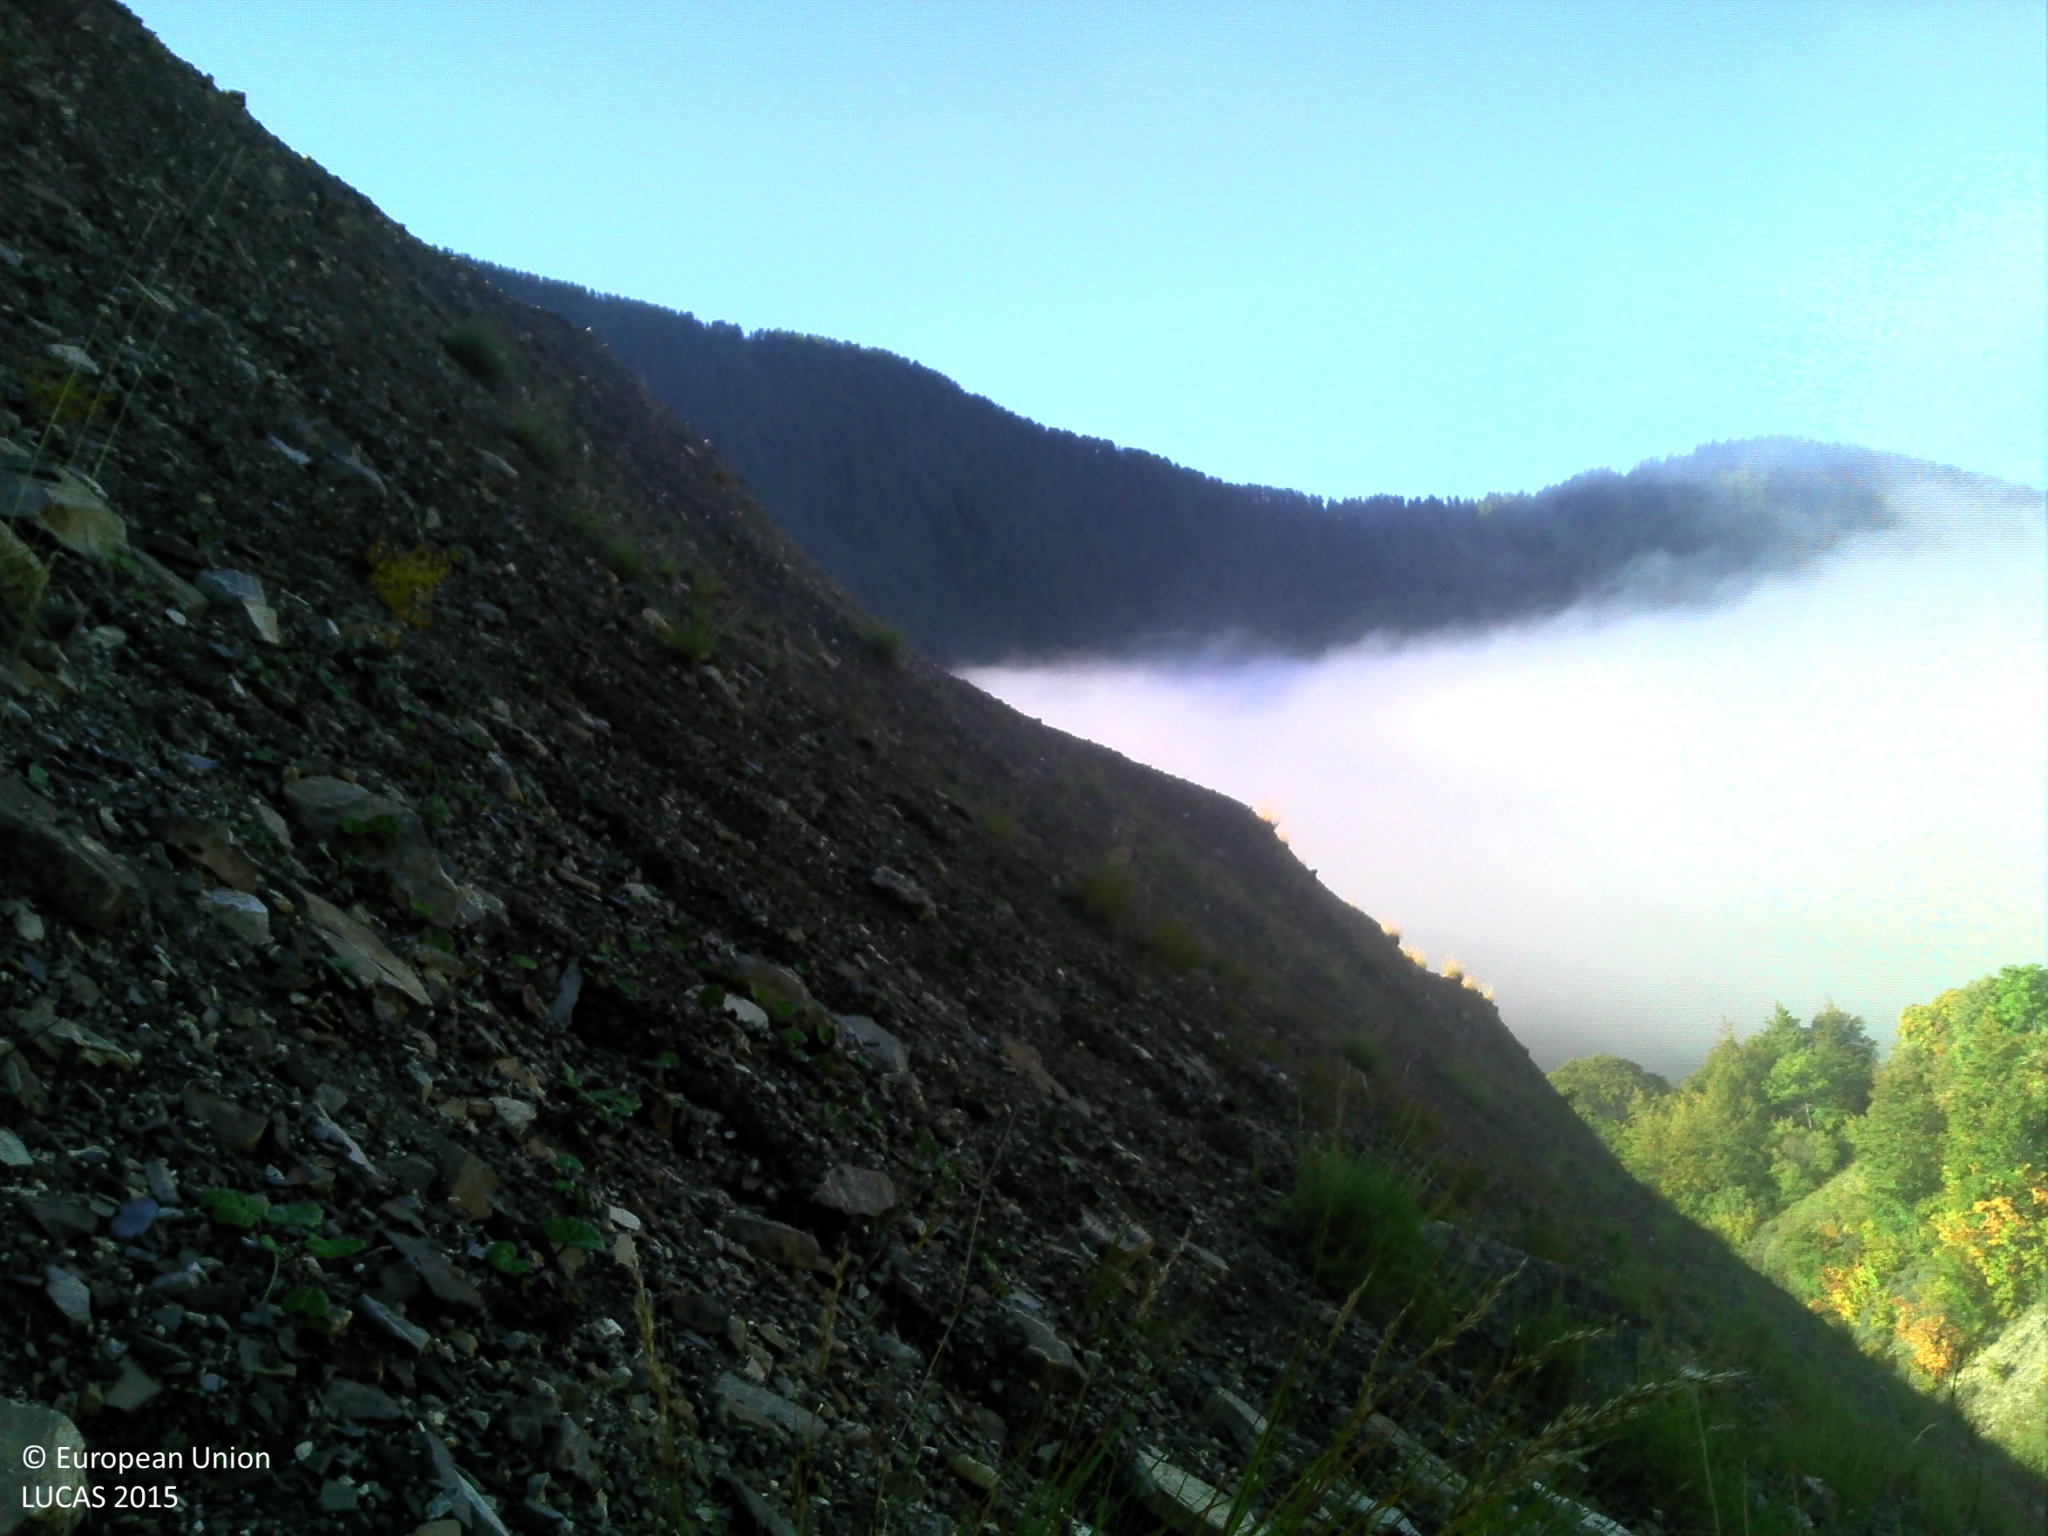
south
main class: Grassland
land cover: Spontaneously vegetated surfaces
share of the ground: 25 - 50 %
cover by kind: consolidated bare surface 60 %, herbaceous plants 40 %
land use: Semi-natural and natural areas not in use
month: September
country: FR
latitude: 44.6254
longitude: 6.2378
